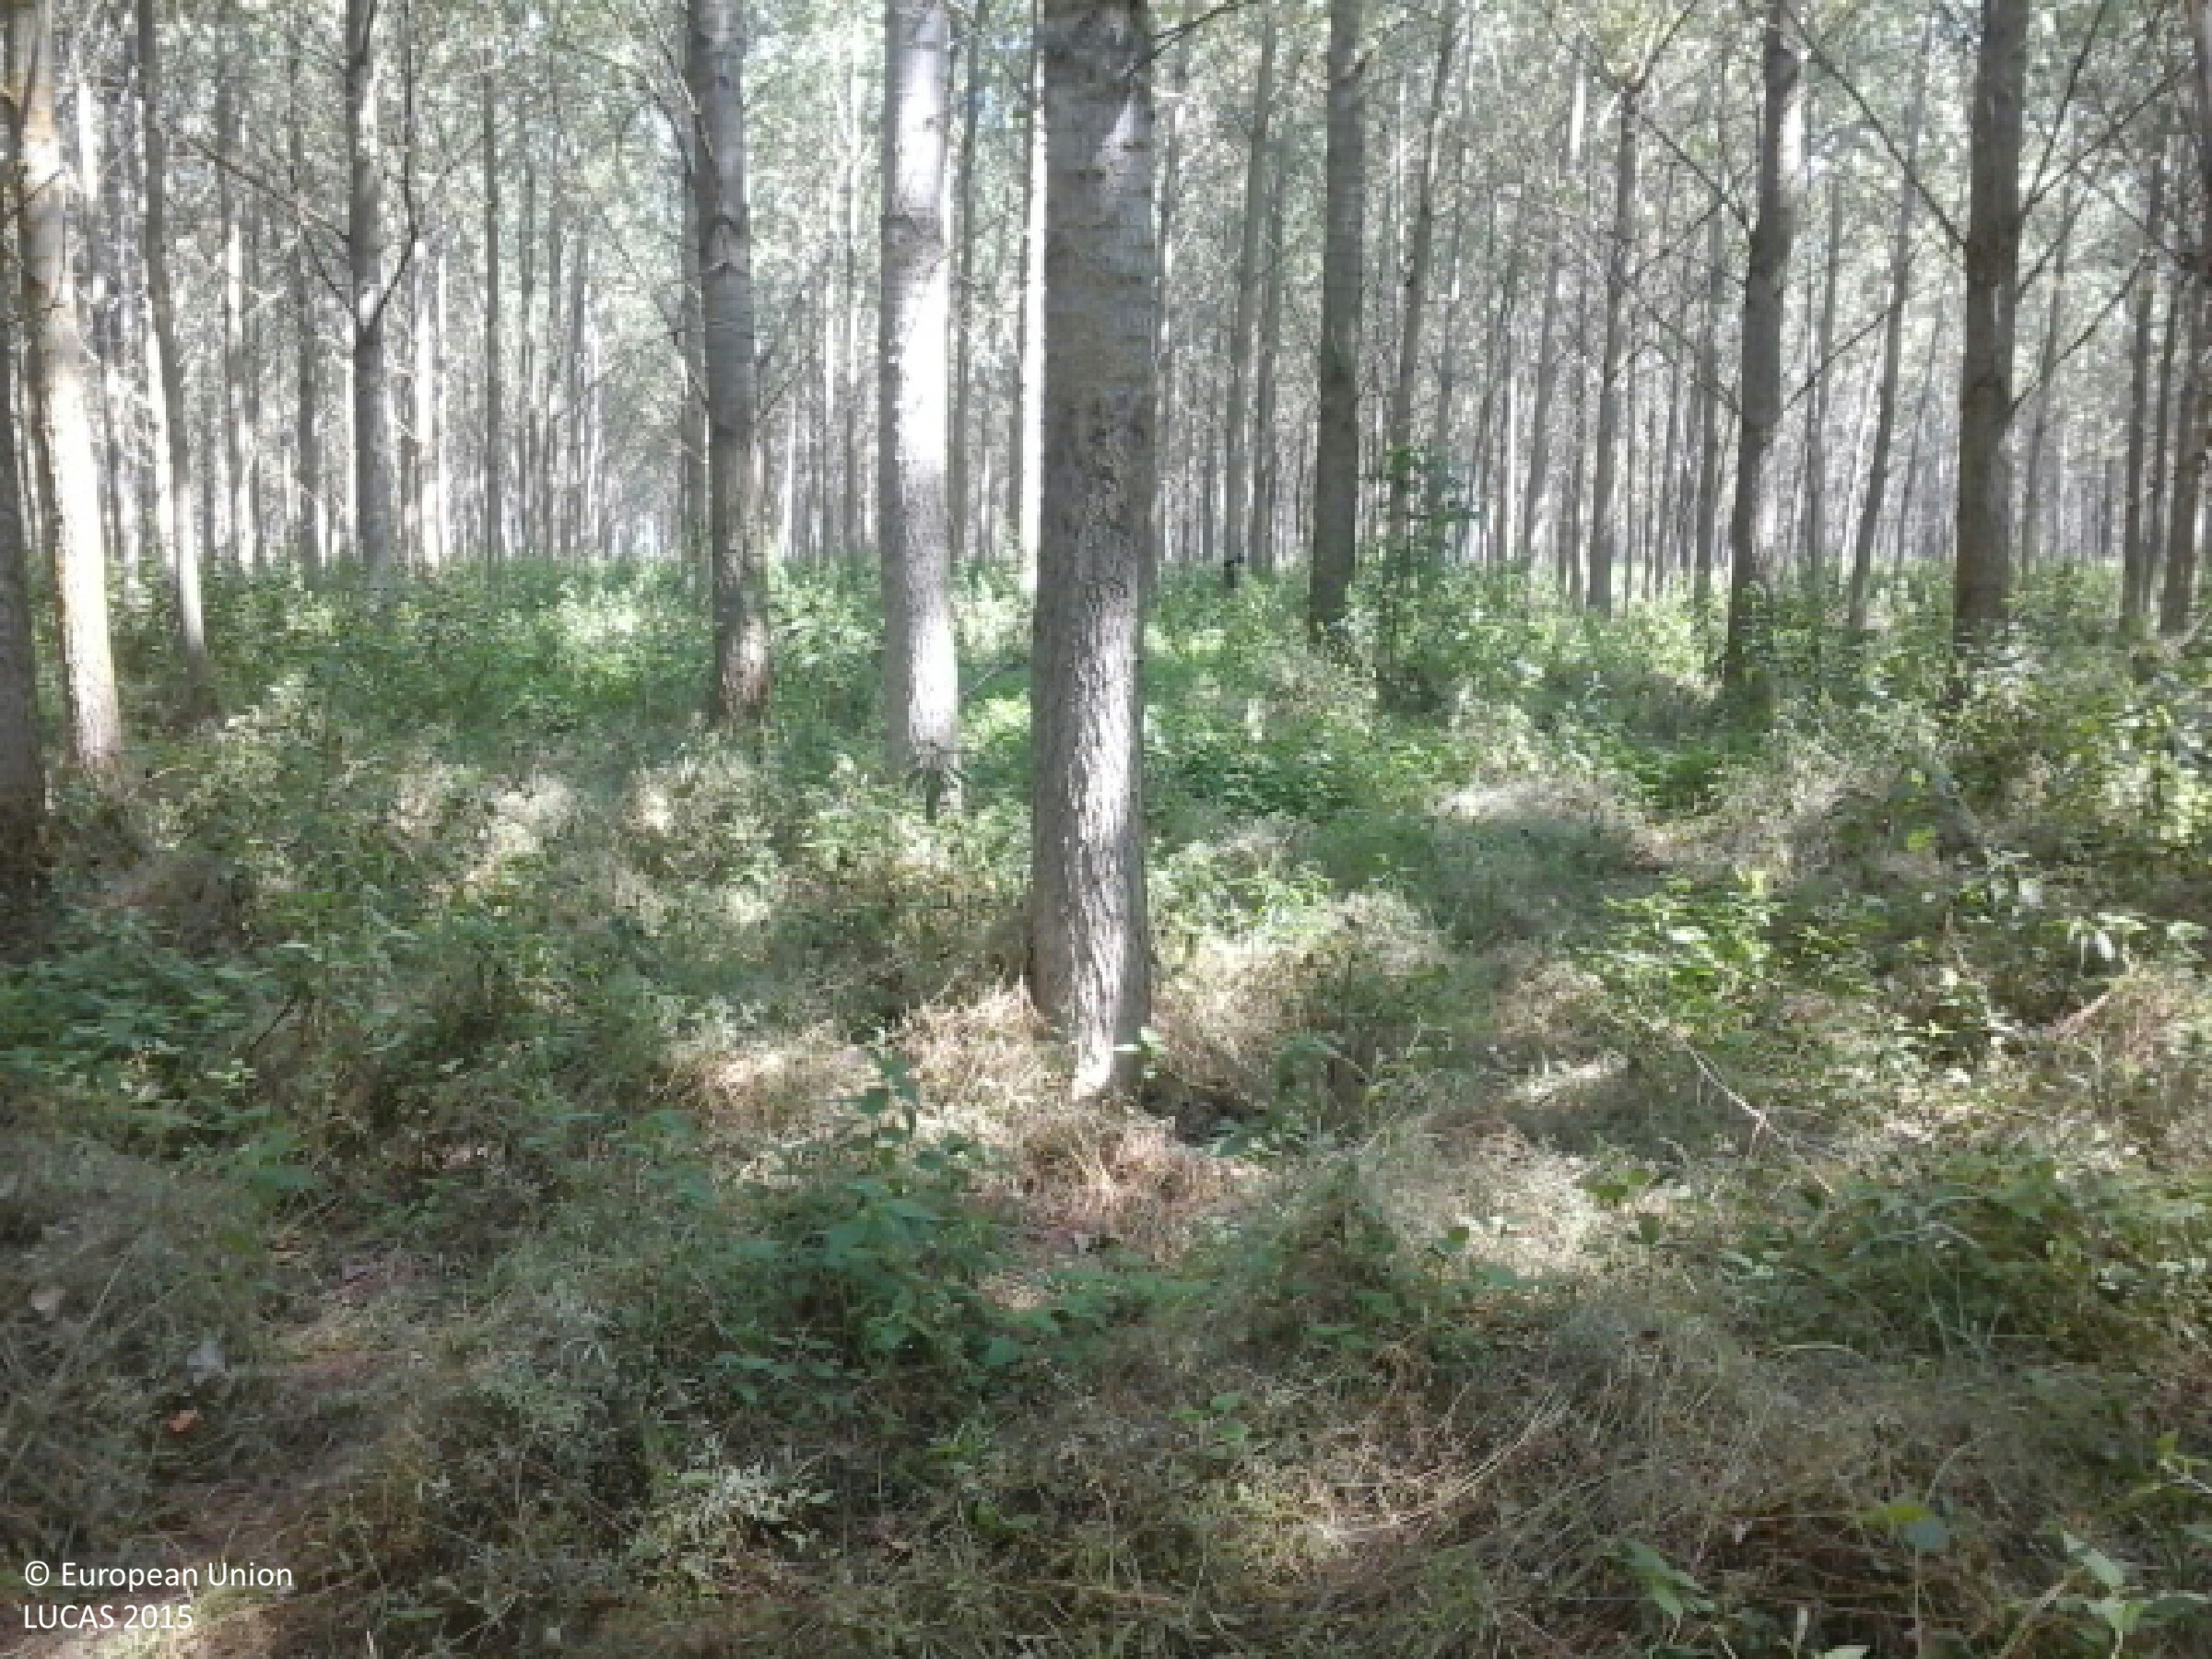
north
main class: Woodland
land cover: Broadleaved woodland
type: non-riverine alder, birch or aspen forest
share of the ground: > 75 %
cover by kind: broadleaved forest trees 95 %, herbaceous plants 5 %
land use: Forestry
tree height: > 5 m
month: June
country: HU
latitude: 48.1795
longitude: 21.8728
